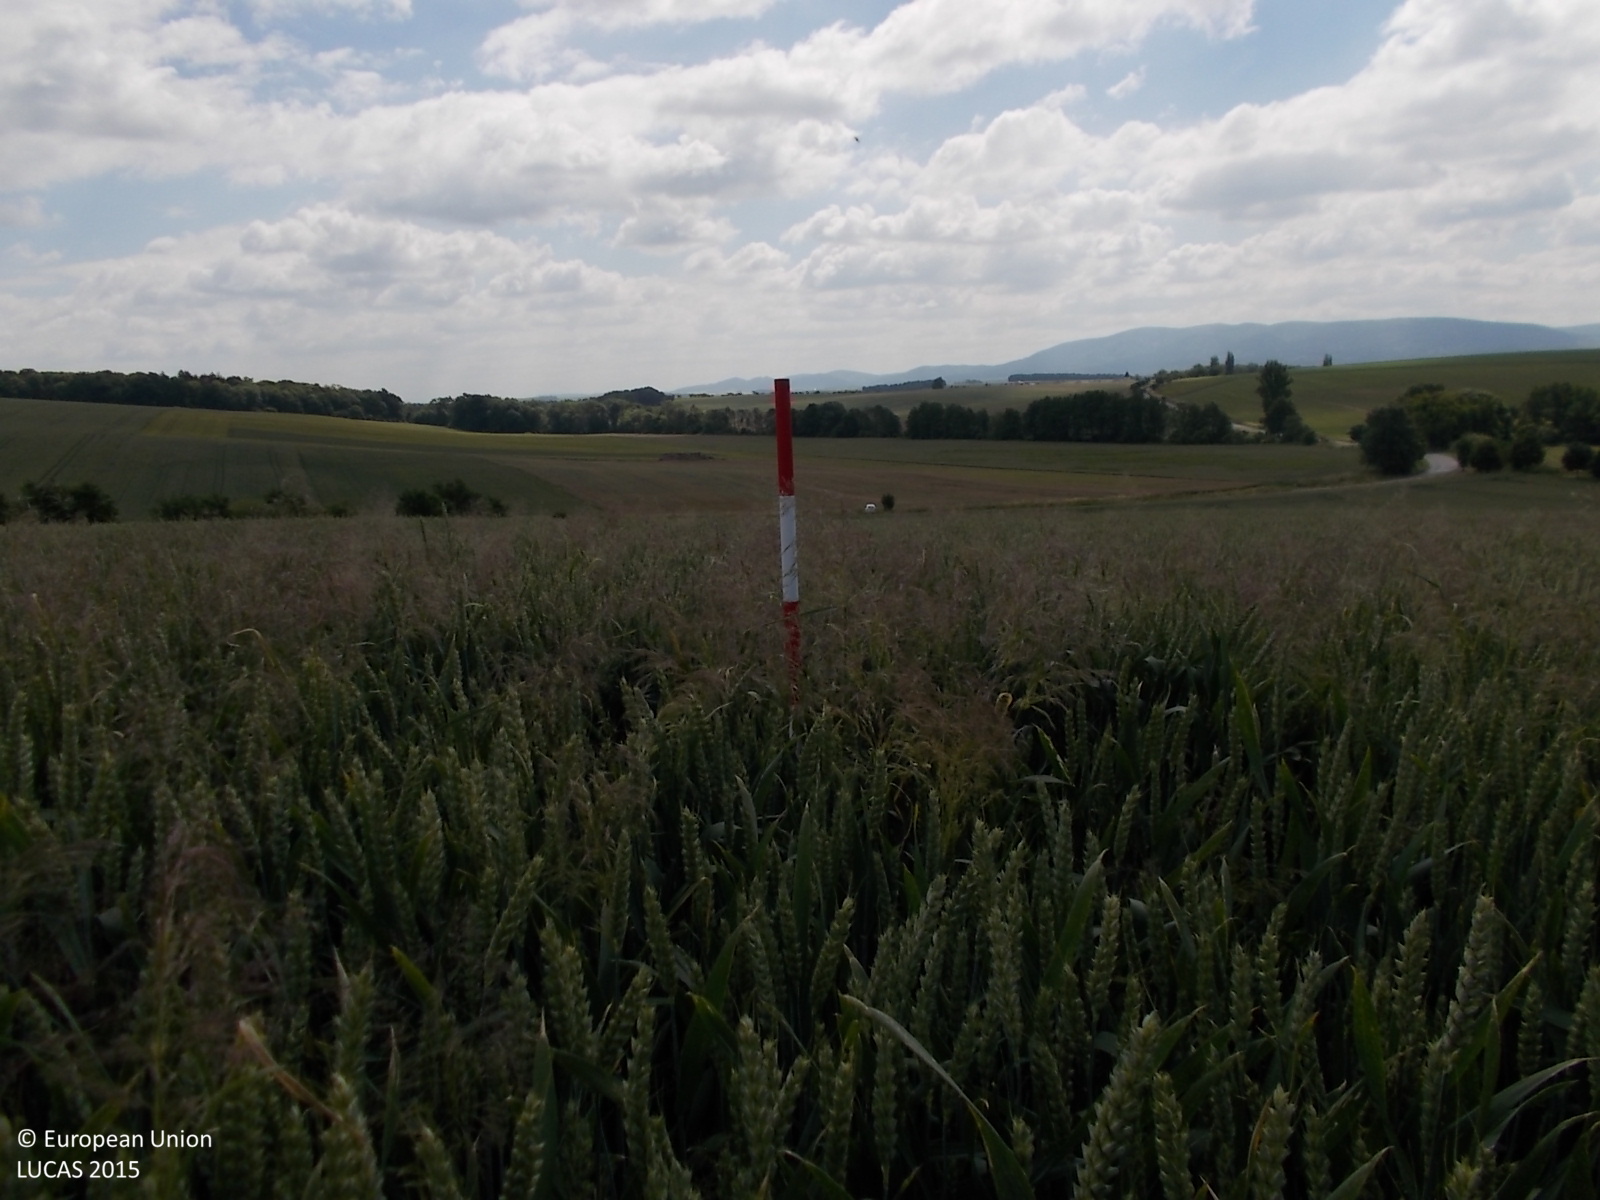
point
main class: Cropland
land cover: Common wheat
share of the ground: > 75 %
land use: Agriculture (excluding fallow land and kitchen gardens)
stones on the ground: < 10 %
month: June
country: CZ
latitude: 49.4597
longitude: 17.6146
